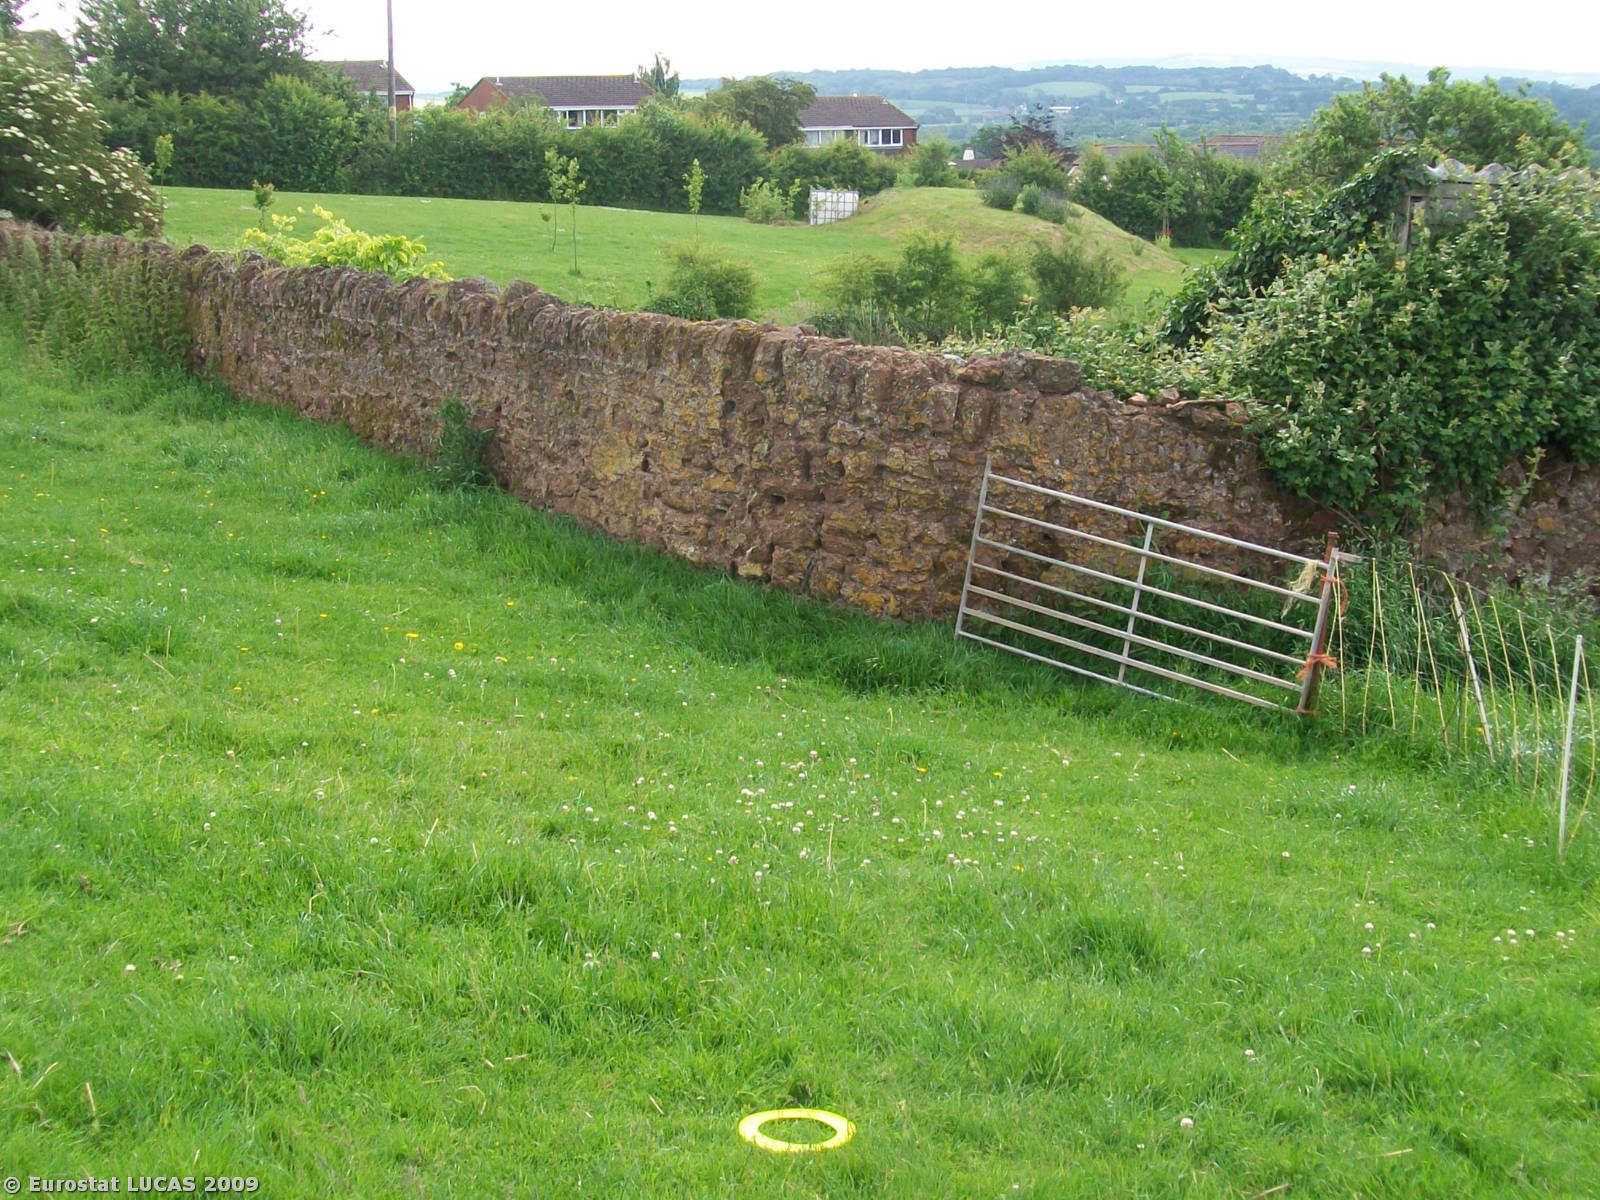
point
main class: Grassland
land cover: Grassland without tree/shrub cover
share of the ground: > 75 %
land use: Agriculture (excluding fallow land and kitchen gardens)
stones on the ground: < 10 %
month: June
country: GB
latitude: 50.9223
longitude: -3.3831
